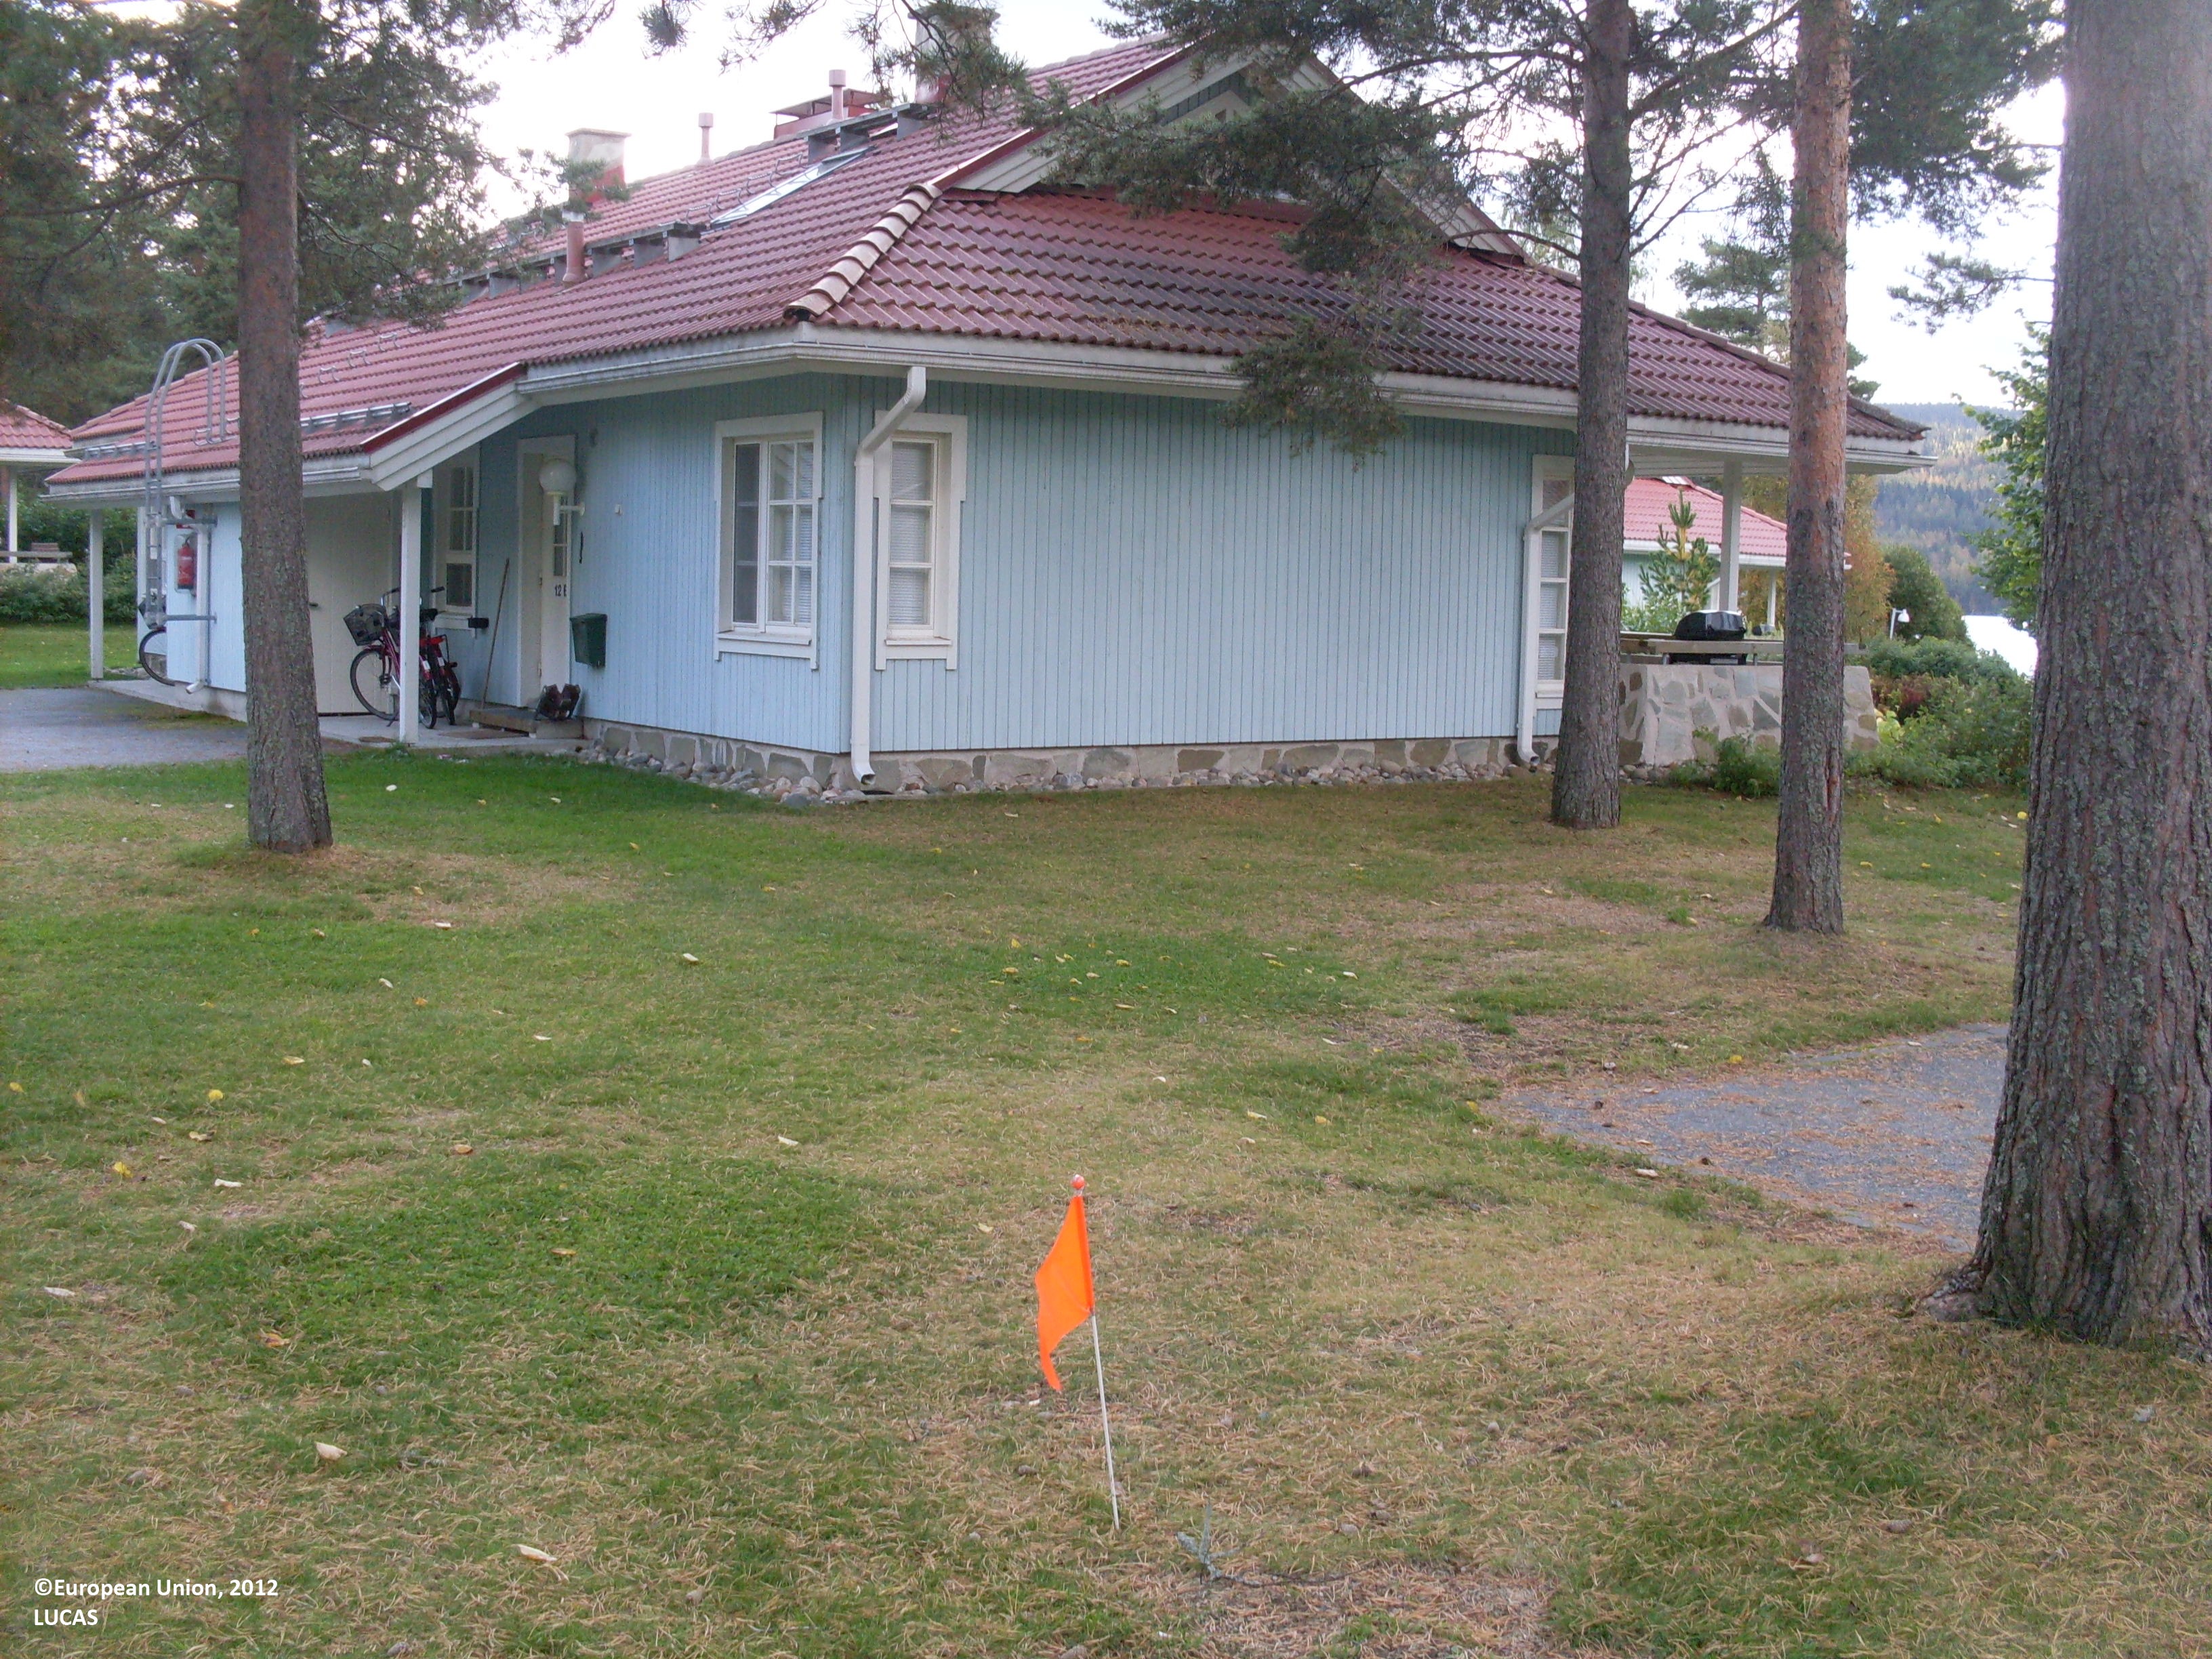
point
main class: Grassland
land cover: Grassland with sparse tree/shrub cover
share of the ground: > 75 %
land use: Residential
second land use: Holiday camps
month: September
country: FI
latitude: 64.1468
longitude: 28.2385
